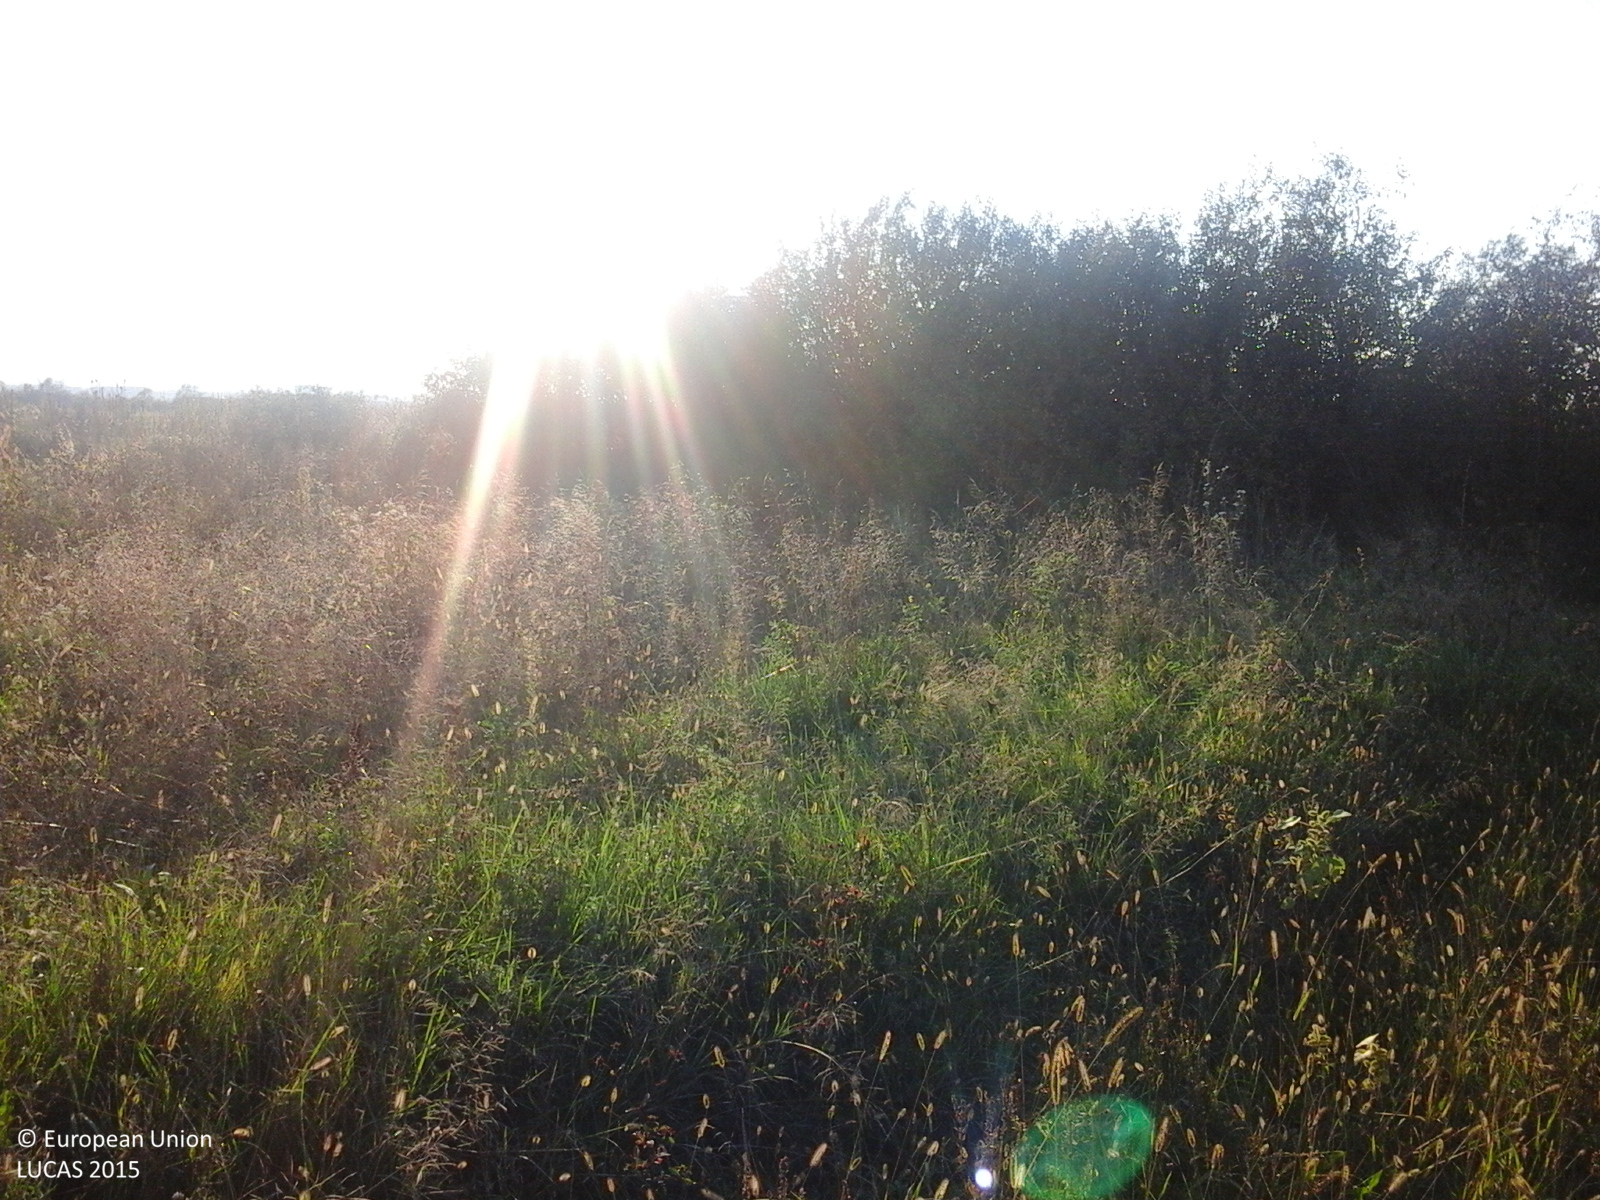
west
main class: Grassland
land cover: Spontaneously vegetated surfaces
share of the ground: > 75 %
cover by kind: herbaceous plants 100 %
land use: Fallow land
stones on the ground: < 10 %
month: September
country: RO
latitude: 45.0069
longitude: 23.5706
